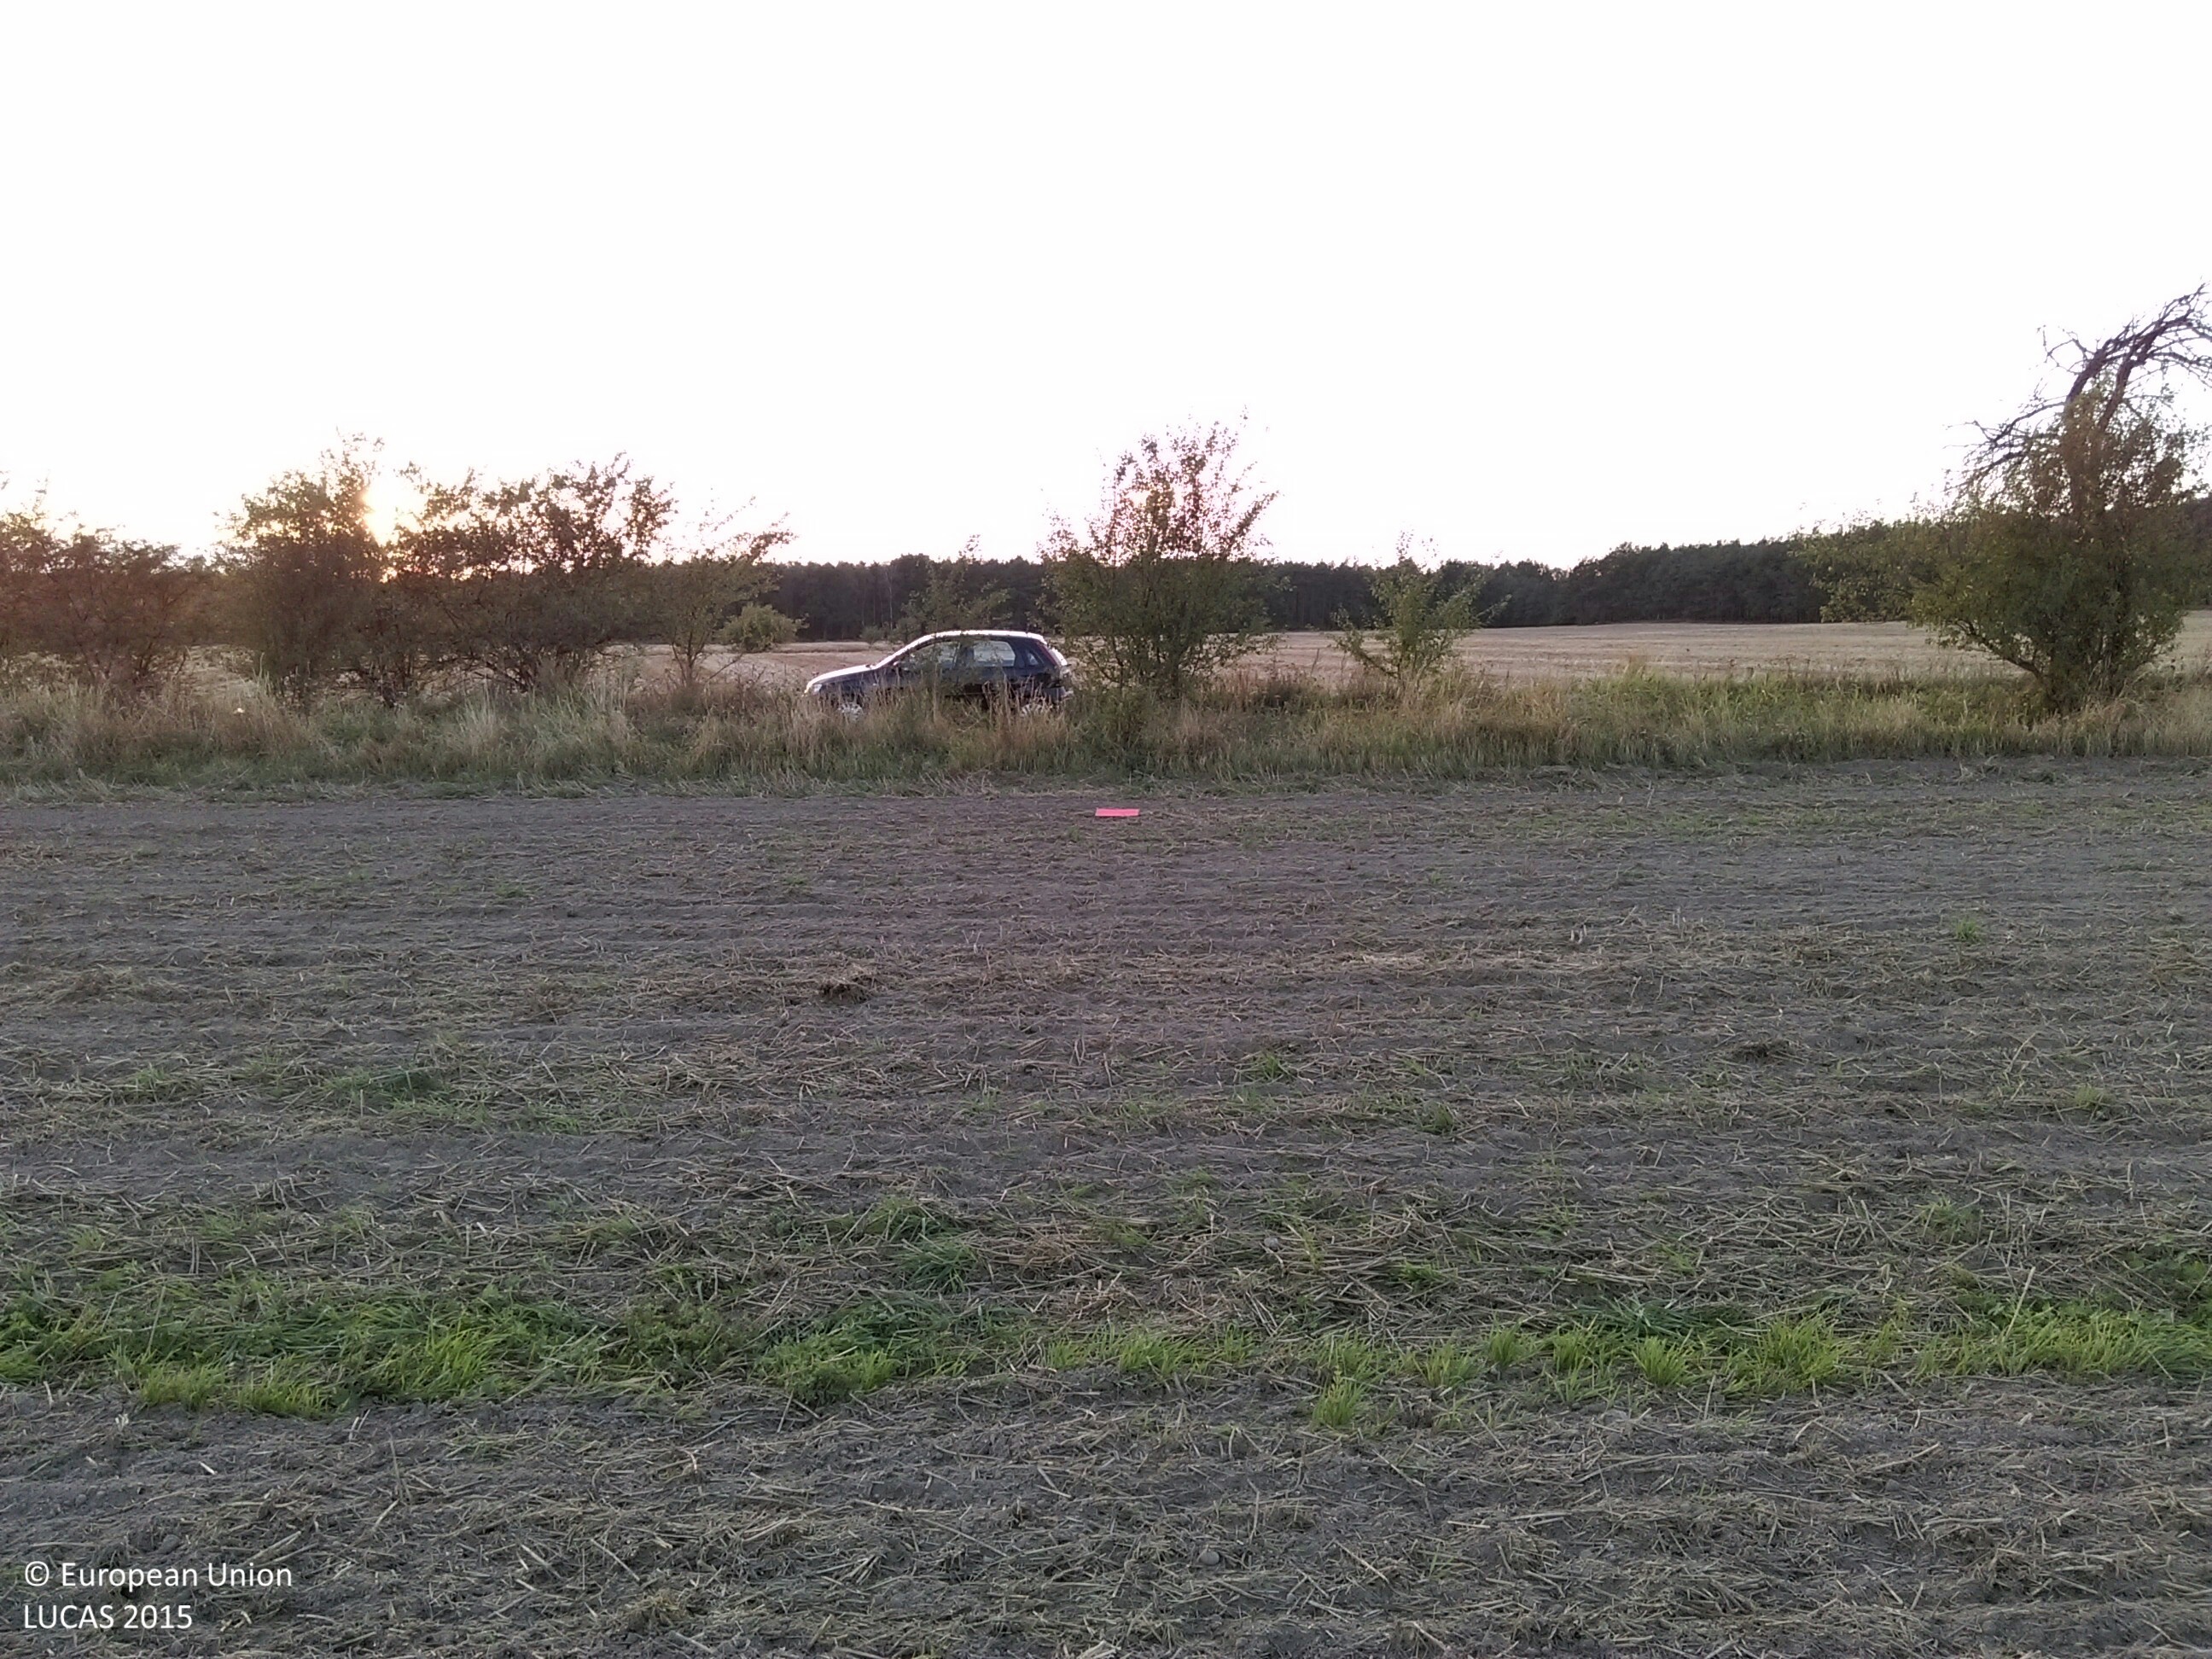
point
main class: Cropland
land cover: Rye
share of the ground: 10 - 25 %
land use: Agriculture (excluding fallow land and kitchen gardens)
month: September
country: PL
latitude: 52.1261
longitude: 16.1851
